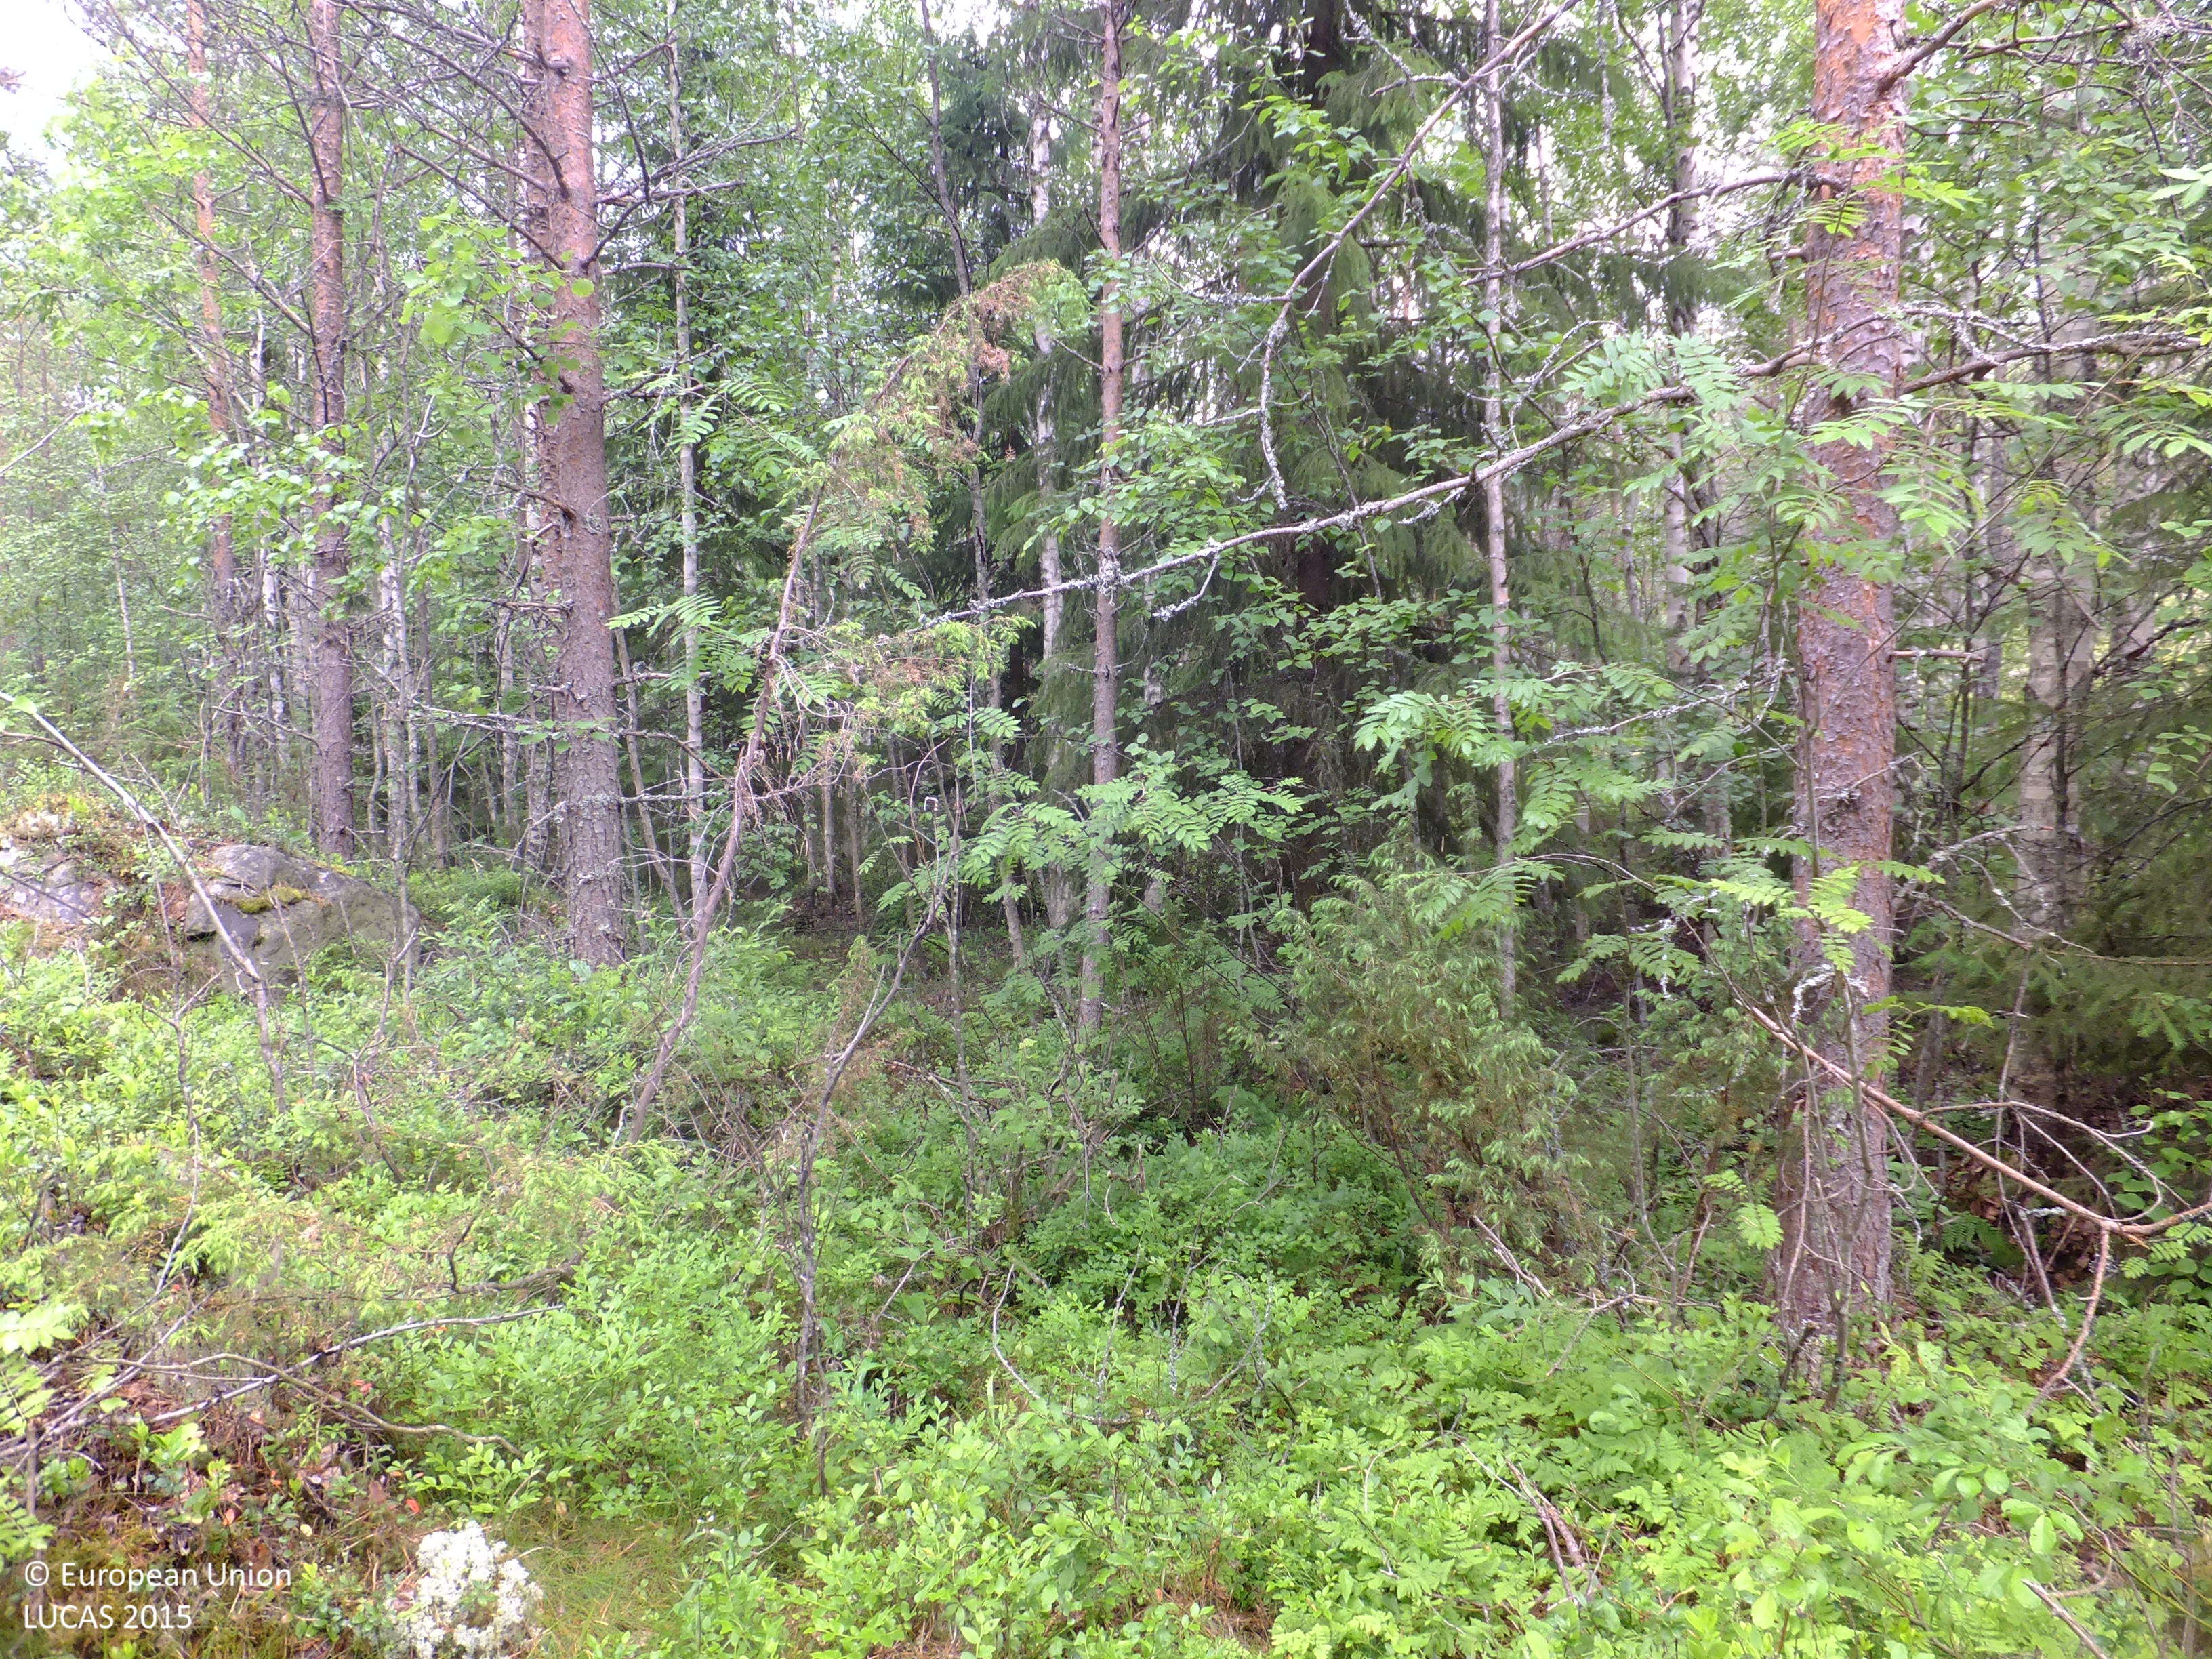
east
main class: Woodland
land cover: Pine dominated mixed woodland
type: boreal forest
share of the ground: 50 - 75 %
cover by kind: coniferous forest trees 40 %, broadleaved forest trees 20 %, shrubs 15 %, lichens and mosses 15 %, herbaceous plants 5 %, consolidated bare surface 5 %
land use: Forestry
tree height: > 5 m
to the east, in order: Pine dominated mixed woodland; Spruce dominated mixed woodland; Other mixed woodland; Broadleaved woodland; Ditches and canals; Other mixed woodland; Pine dominated coniferous woodland; Inland fresh water bodies
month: July
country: FI
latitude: 63.1715
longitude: 24.7248
